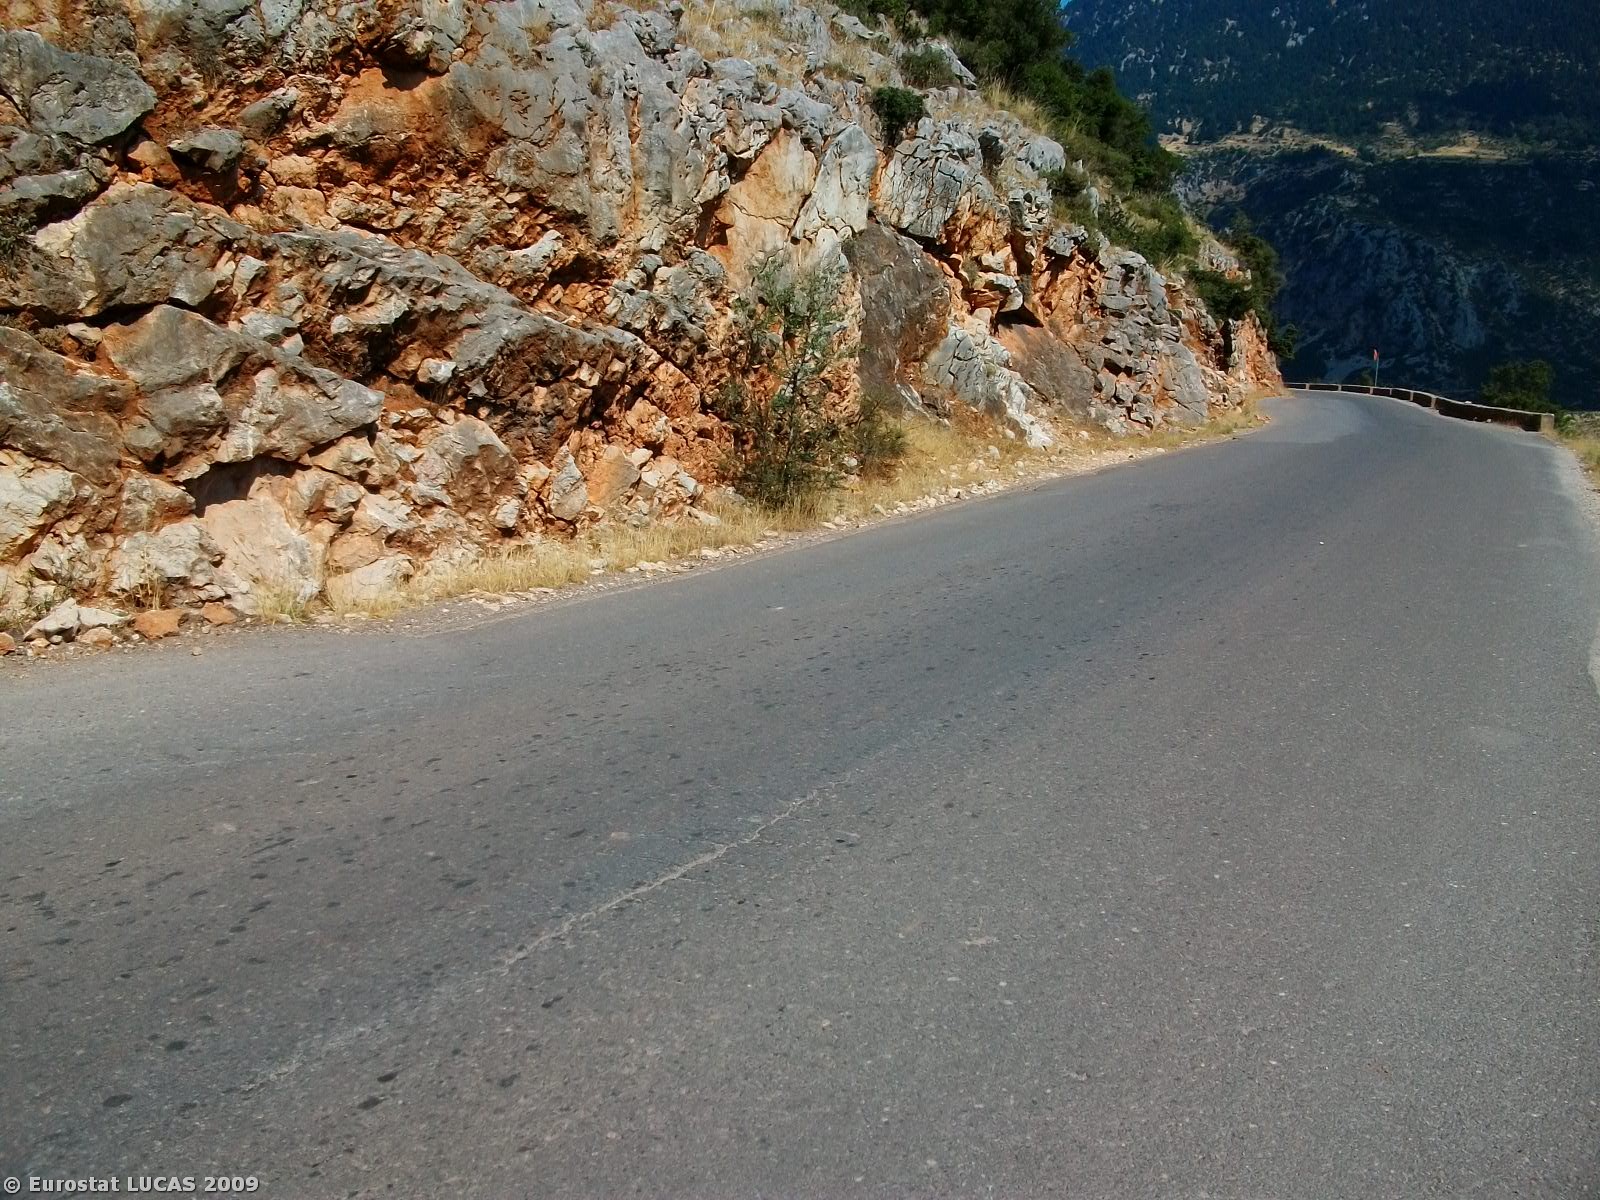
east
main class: Shrubland
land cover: Shrubland with sparse tree cover
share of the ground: 50 - 75 %
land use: Unused
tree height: > 5 m
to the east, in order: Shrubland with sparse tree cover
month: August
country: GR
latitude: 38.6543
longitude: 22.3990
